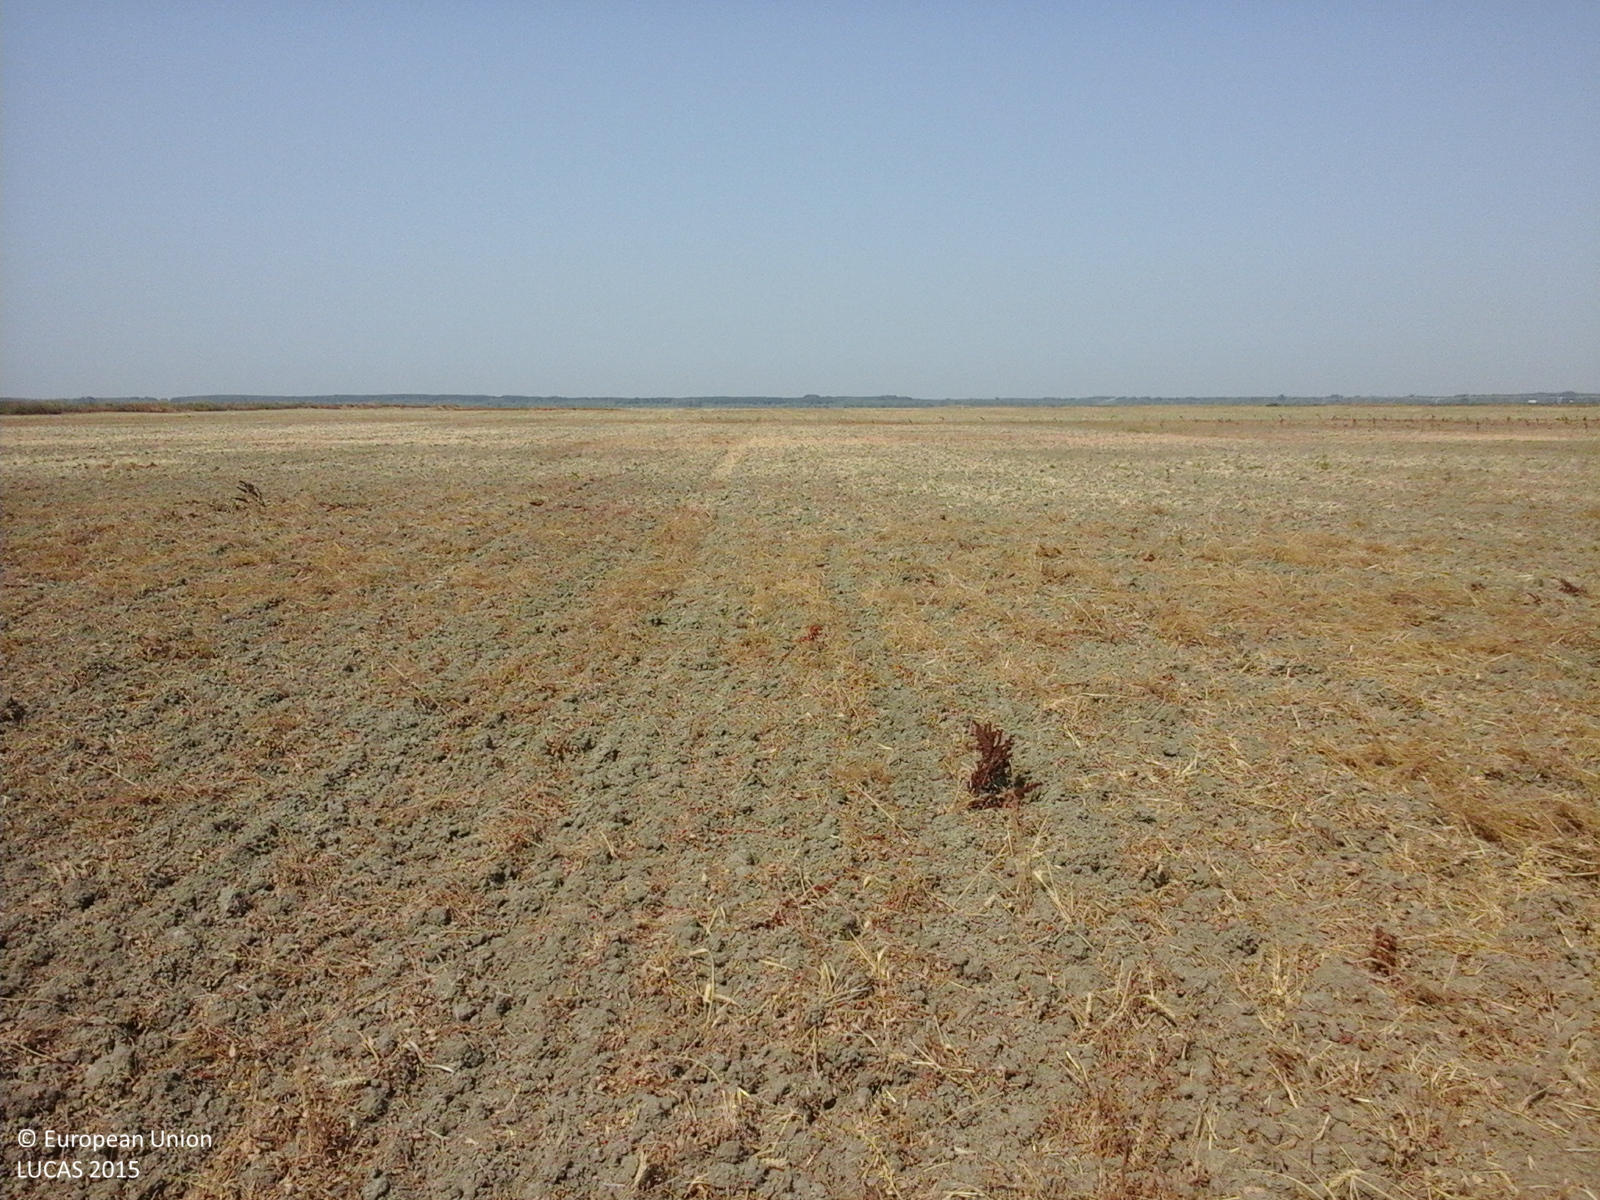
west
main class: Cropland
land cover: Common wheat
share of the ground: < 10 %
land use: Agriculture (excluding fallow land and kitchen gardens)
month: August
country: RO
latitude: 44.9773
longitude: 27.9793
